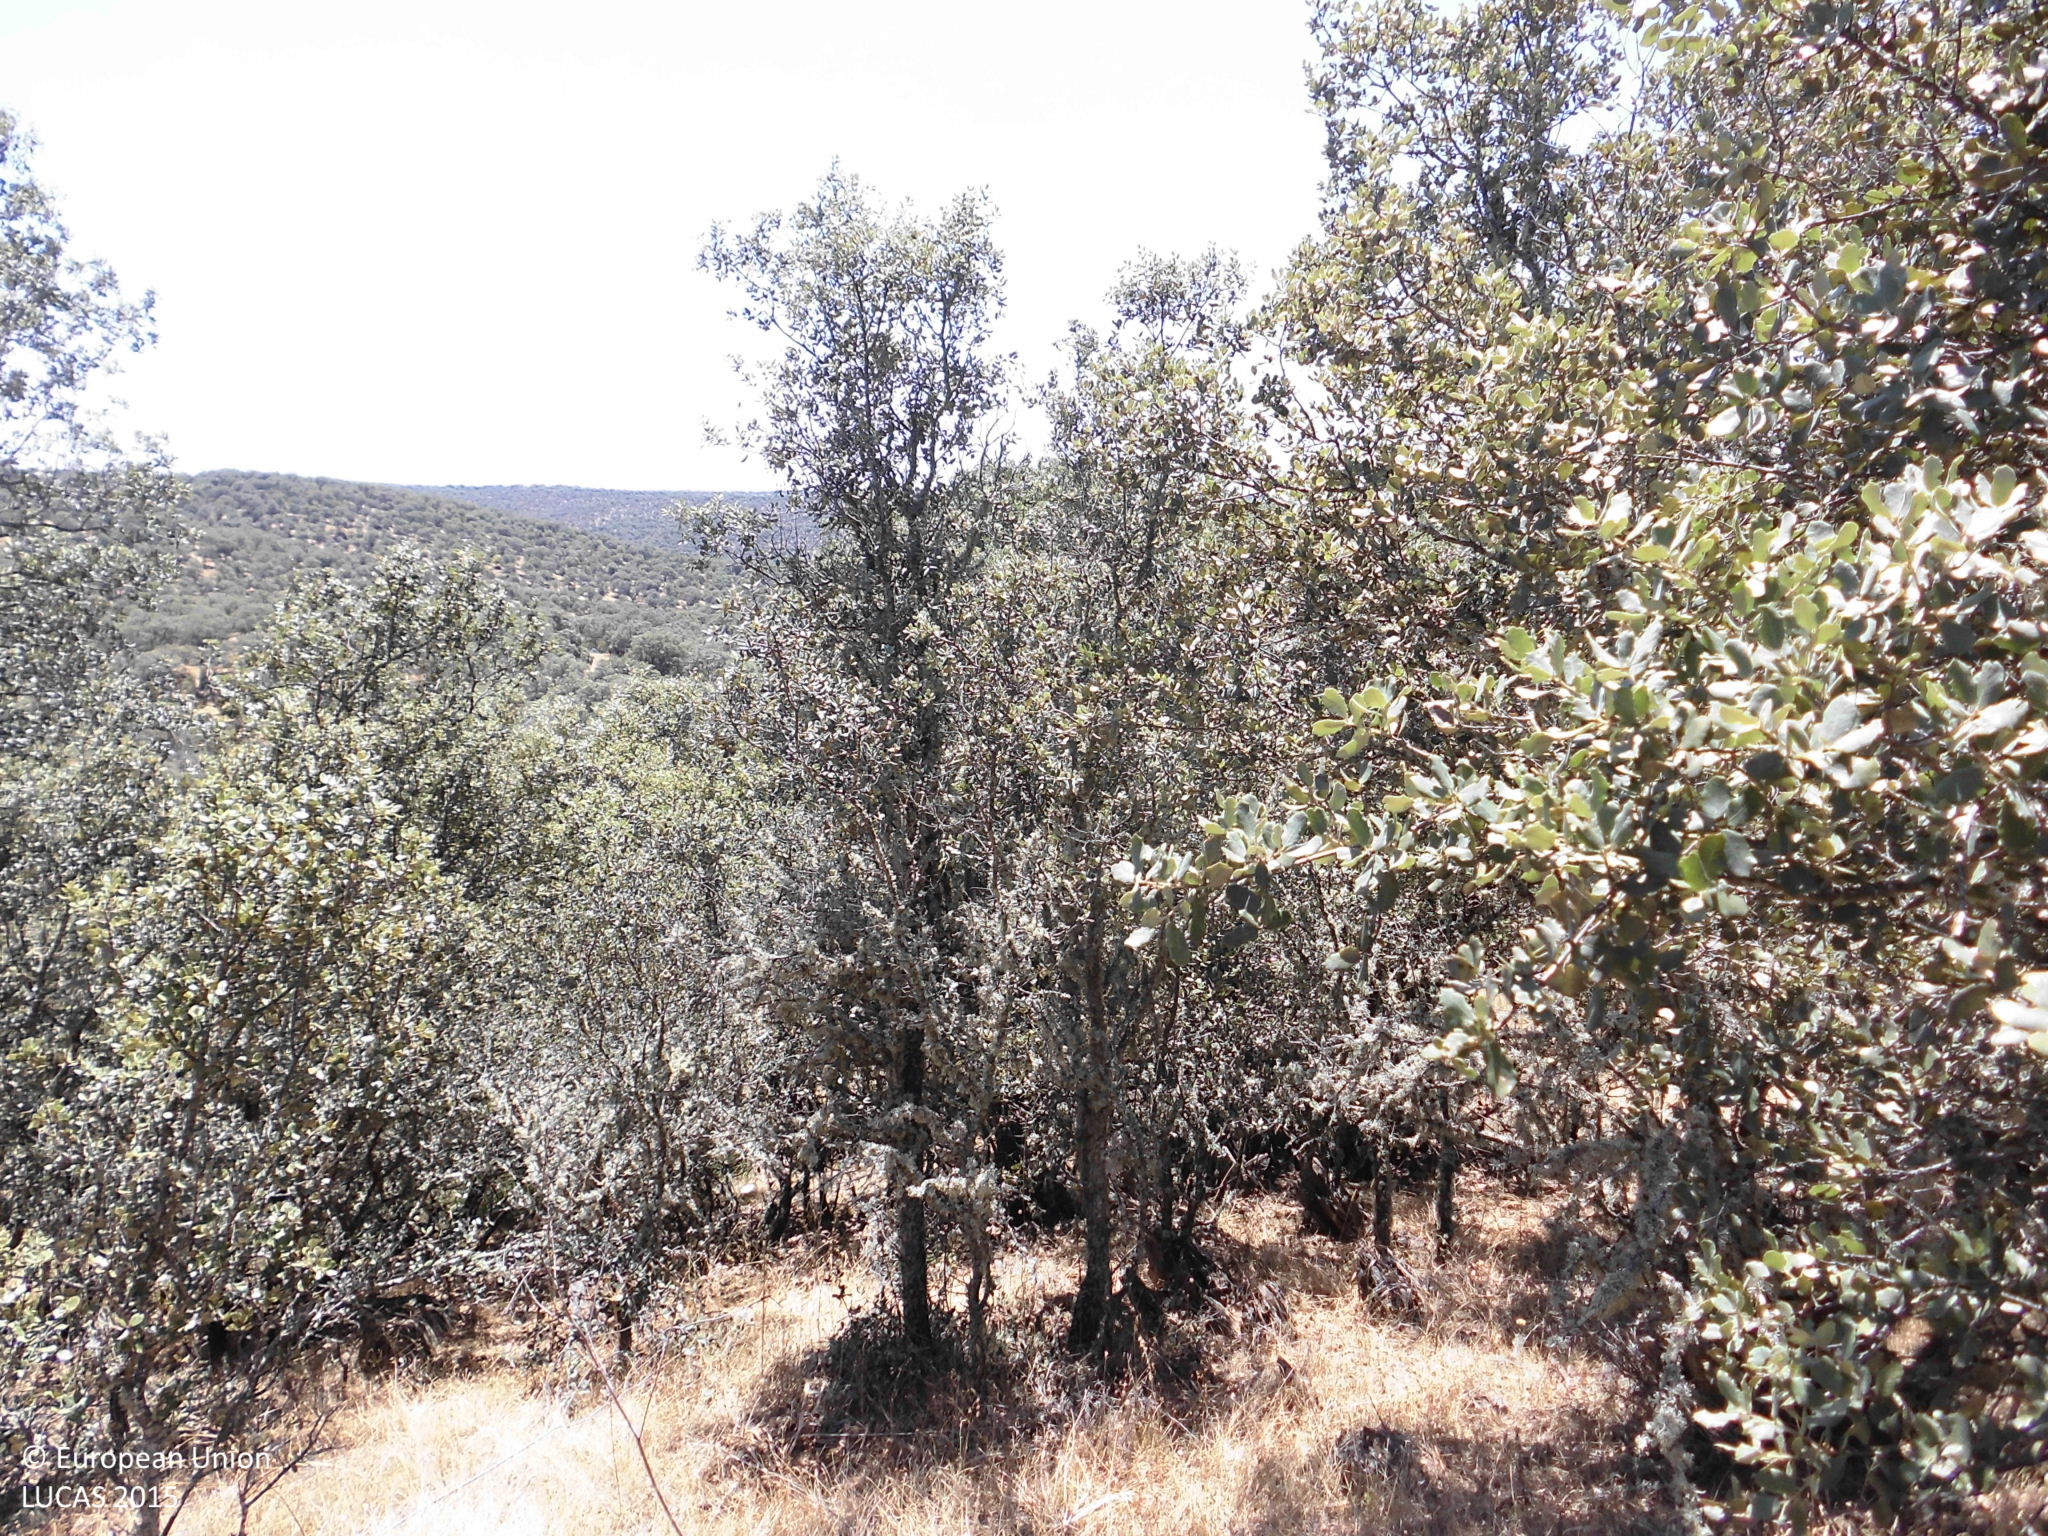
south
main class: Woodland
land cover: Broadleaved woodland
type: broadleaved evergreen forest
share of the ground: 50 - 75 %
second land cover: Grassland without tree/shrub cover
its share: > 75 %
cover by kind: broadleaved forest trees 50 %, herbaceous plants 50 %
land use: Semi-natural and natural areas not in use
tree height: > 5 m
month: June
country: ES
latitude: 39.6551
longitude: -6.0433
